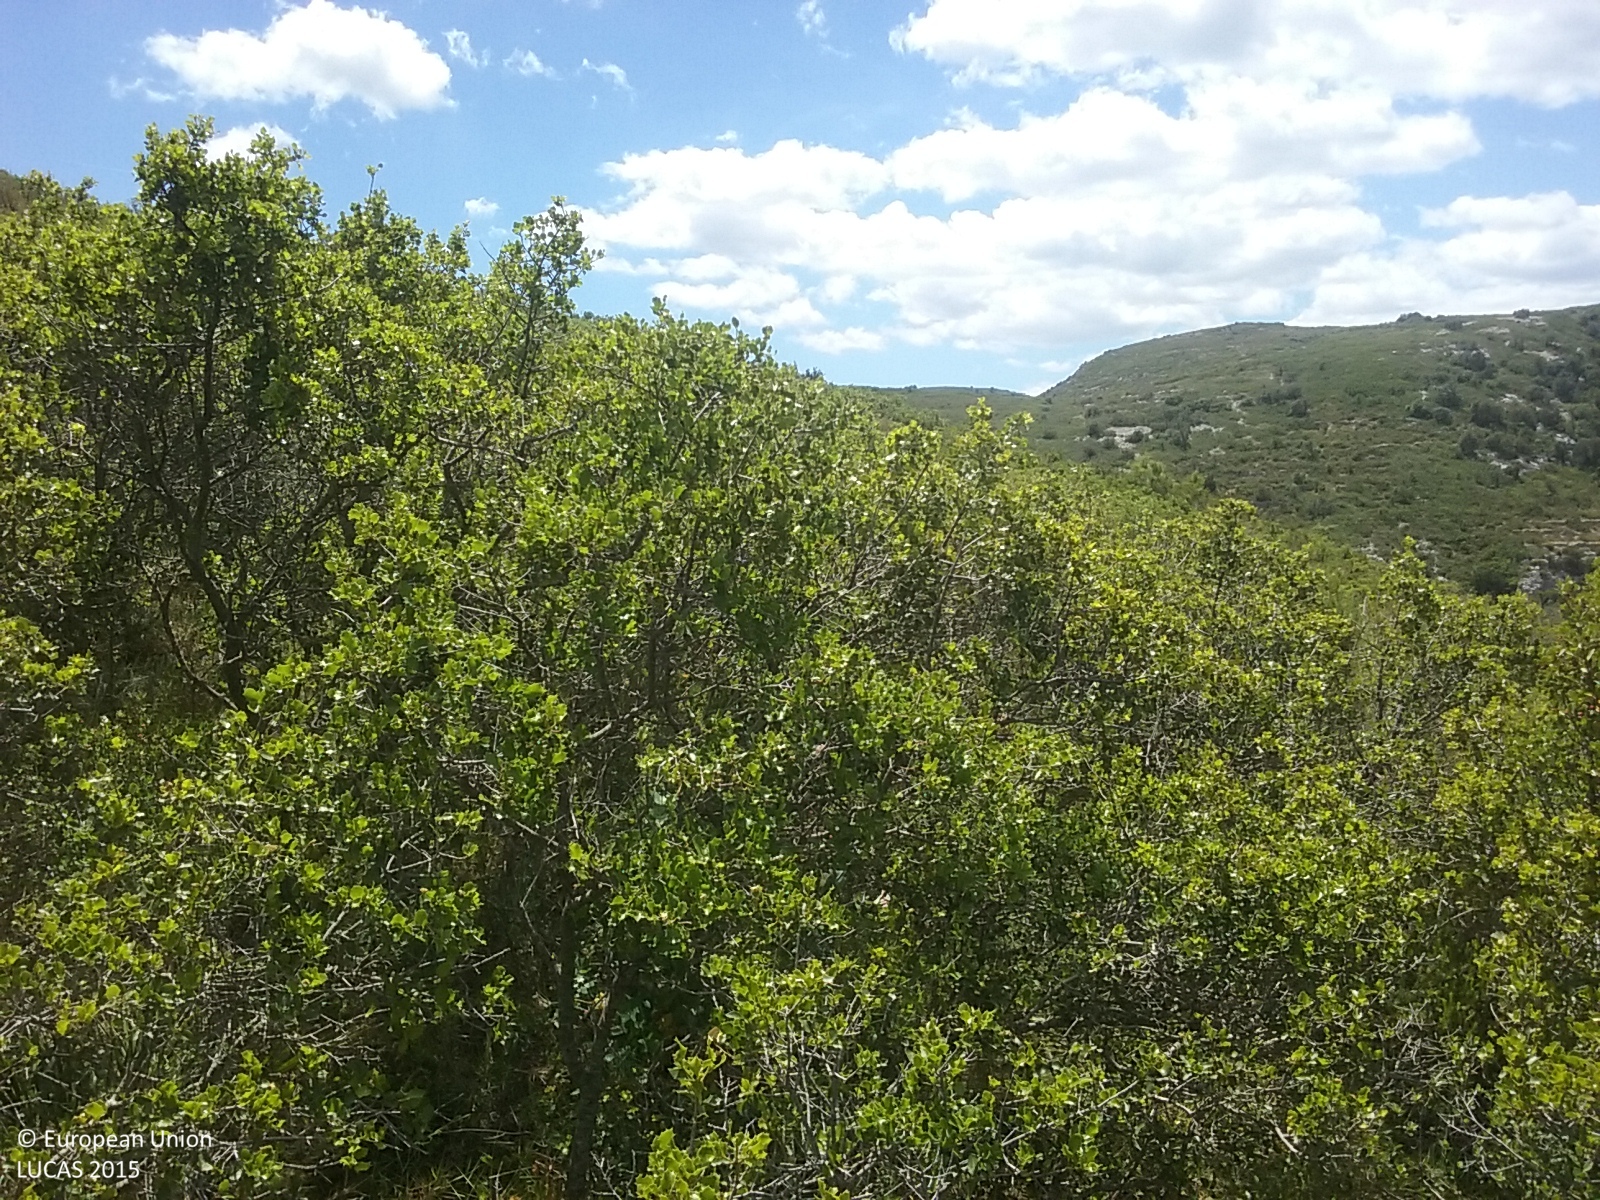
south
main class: Shrubland
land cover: Shrubland without tree cover
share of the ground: > 75 %
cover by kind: shrubs 95 %, herbaceous plants 5 %
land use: Semi-natural and natural areas not in use
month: May
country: ES
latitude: 40.3836
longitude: 0.0893
